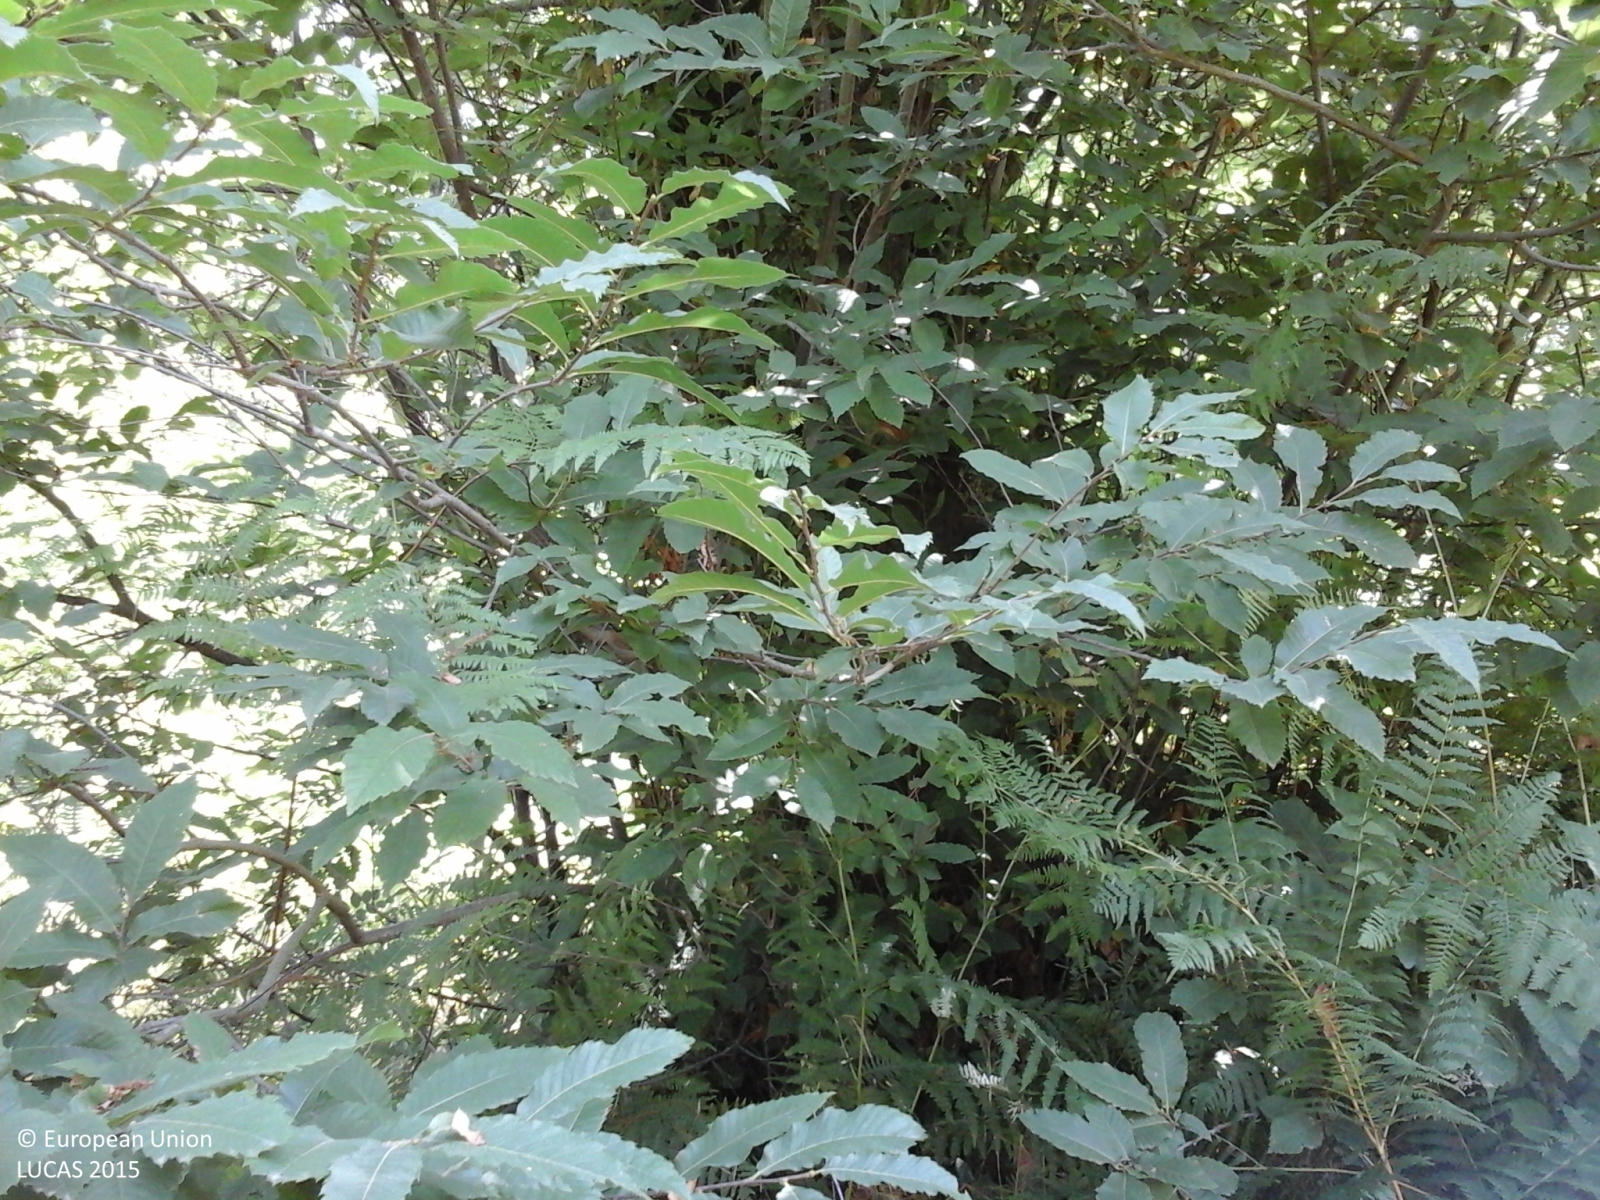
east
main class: Woodland
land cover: Broadleaved woodland
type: thermophilous deciduous forest
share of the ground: > 75 %
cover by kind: broadleaved forest trees 90 %, shrubs 5 %, herbaceous plants 5 %
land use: Semi-natural and natural areas not in use
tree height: > 5 m
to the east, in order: Broadleaved woodland; Fences; Grassland without tree/shrub cover; Artificial constructions in urban areas; Abandoned hedges; Grassland without tree/shrub cover
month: July
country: IT
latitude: 41.5978
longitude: 12.9758
